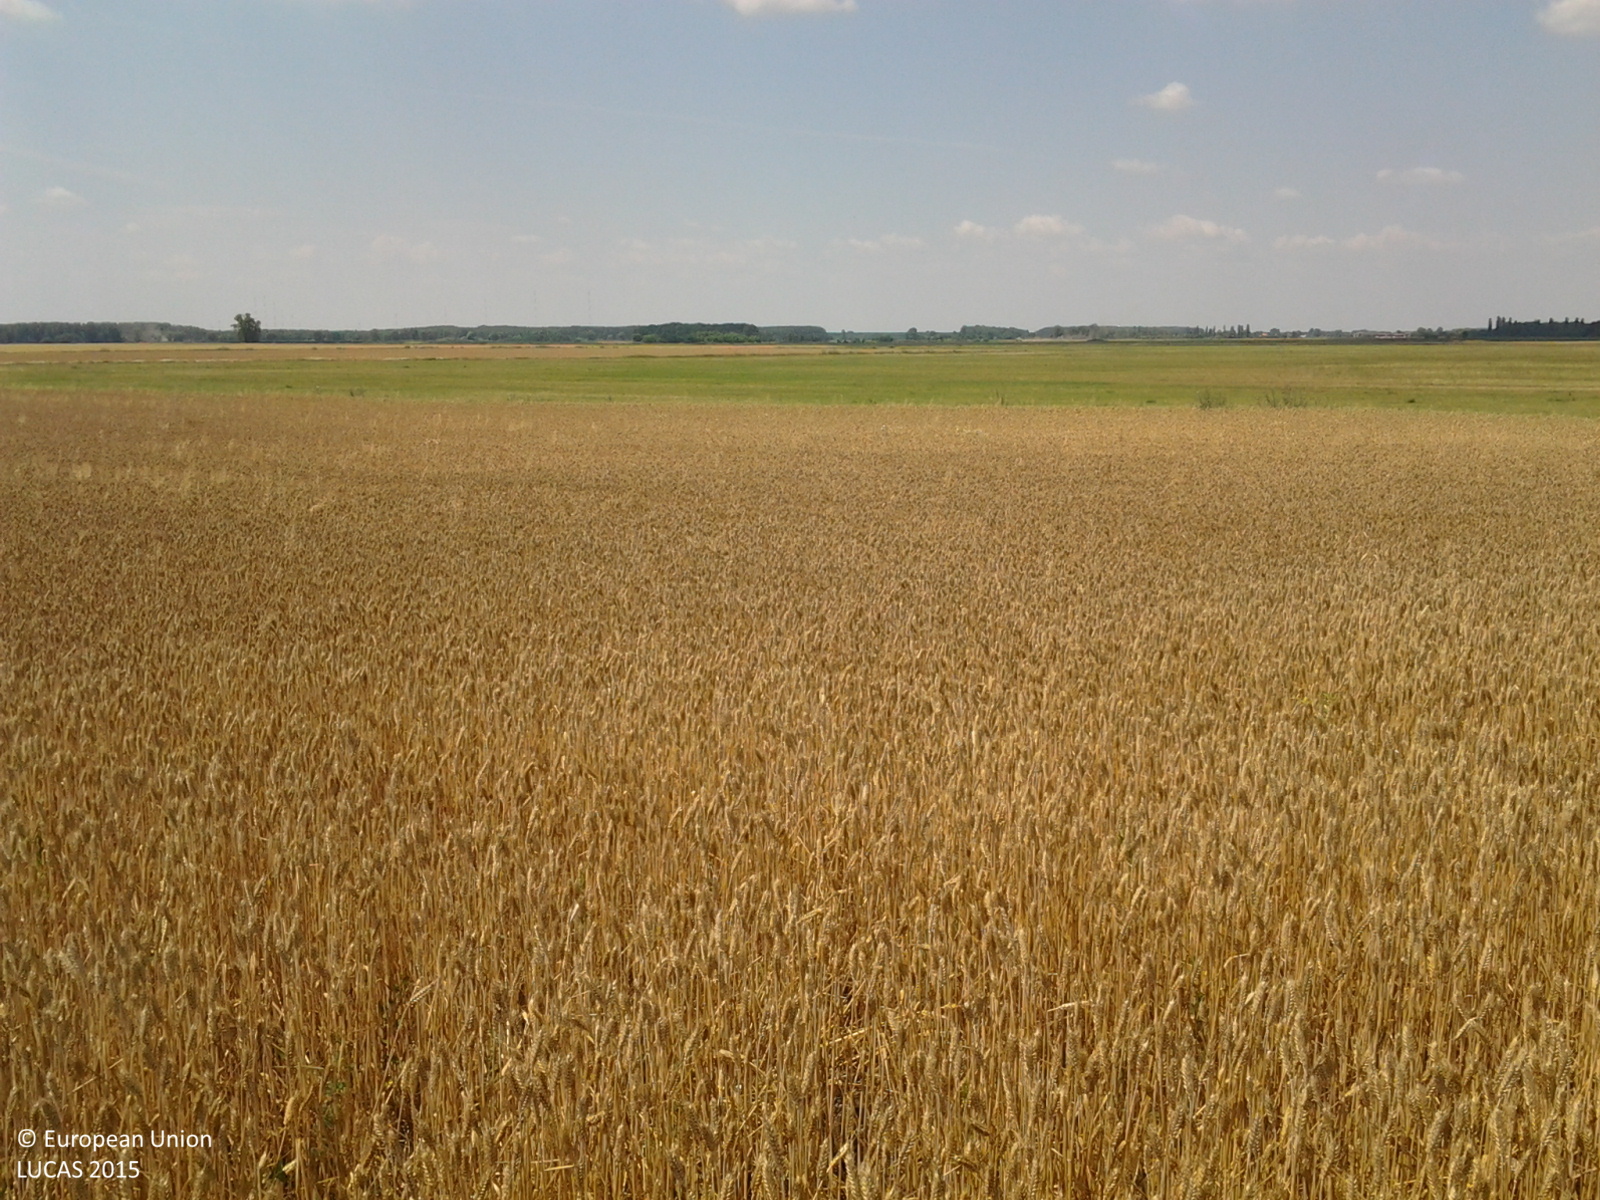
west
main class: Cropland
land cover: Common wheat
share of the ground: > 75 %
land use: Agriculture (excluding fallow land and kitchen gardens)
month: July
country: HU
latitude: 47.5950
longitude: 19.9067
